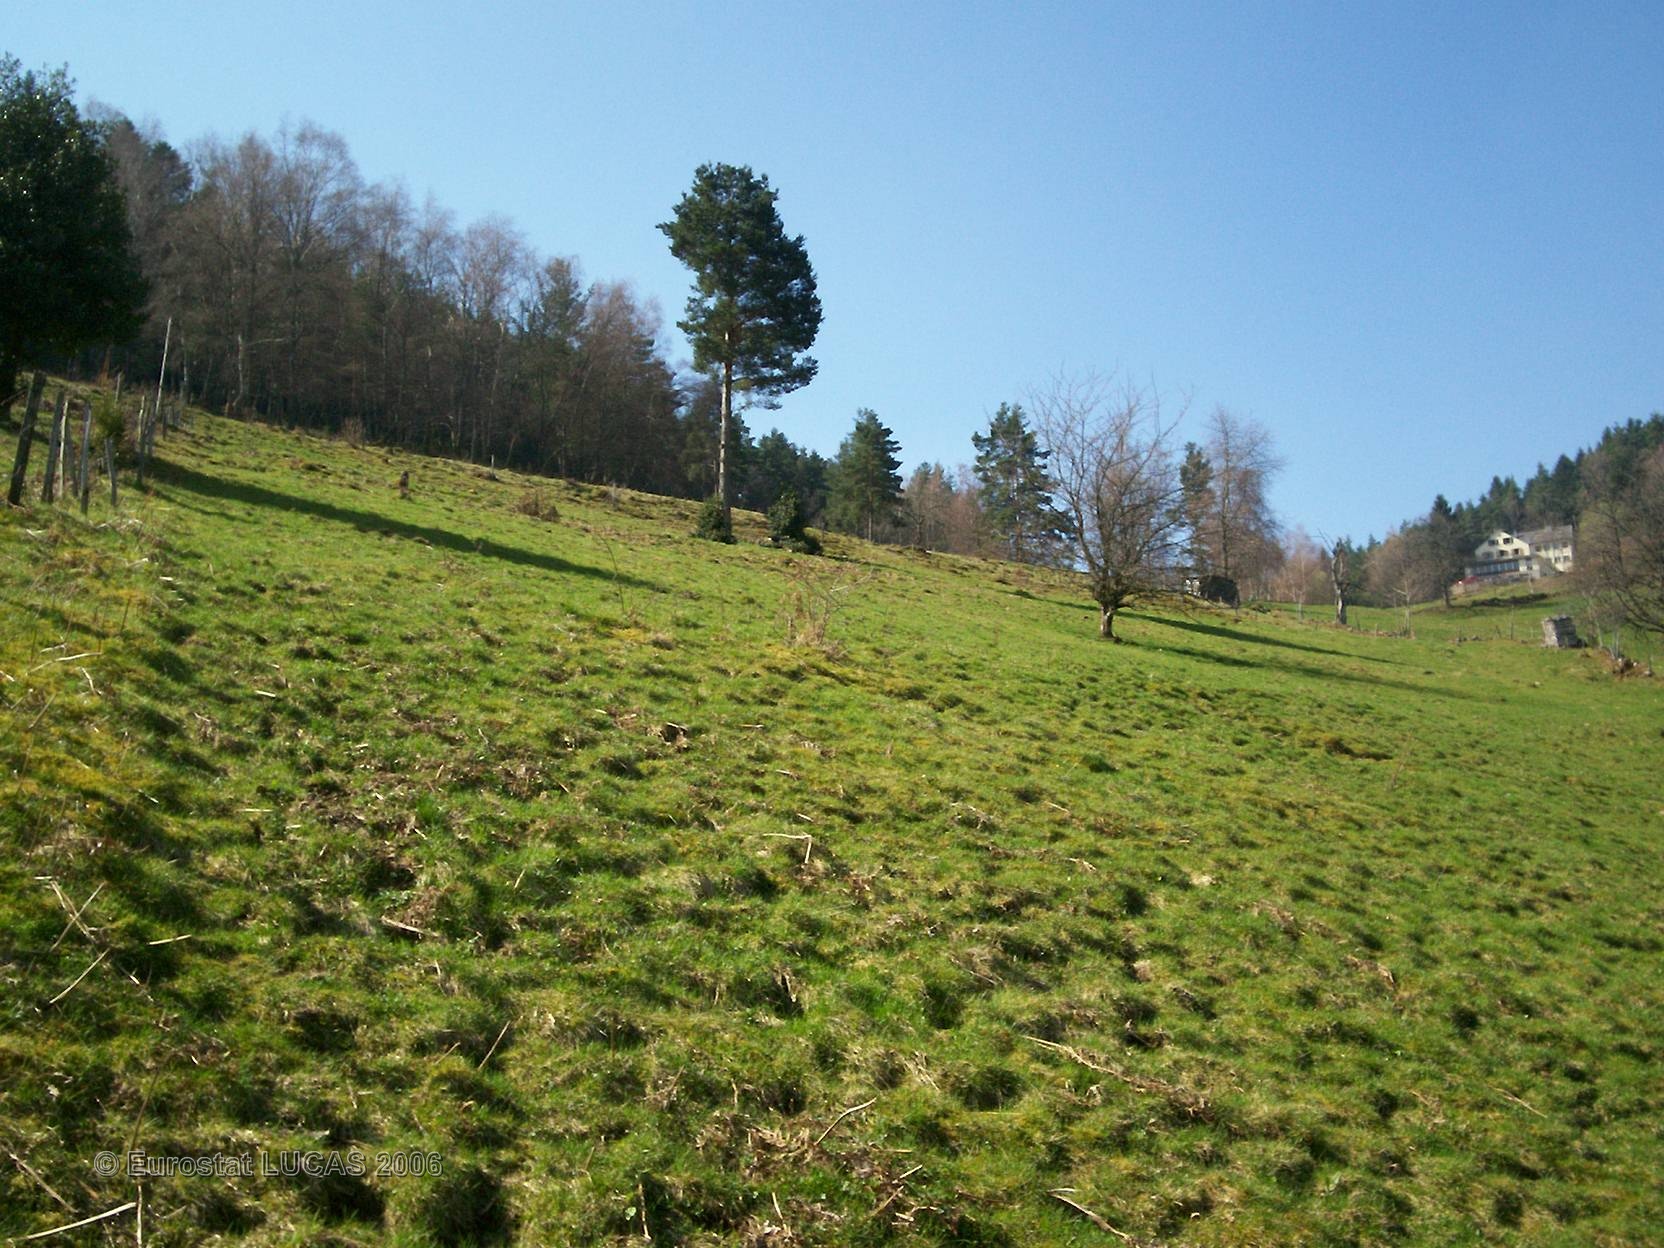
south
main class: Grassland
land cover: Grassland without tree/shrub cover
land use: Agriculture (excluding fallow land and kitchen gardens)
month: April
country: FR
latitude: 48.0411
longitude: 7.0905
